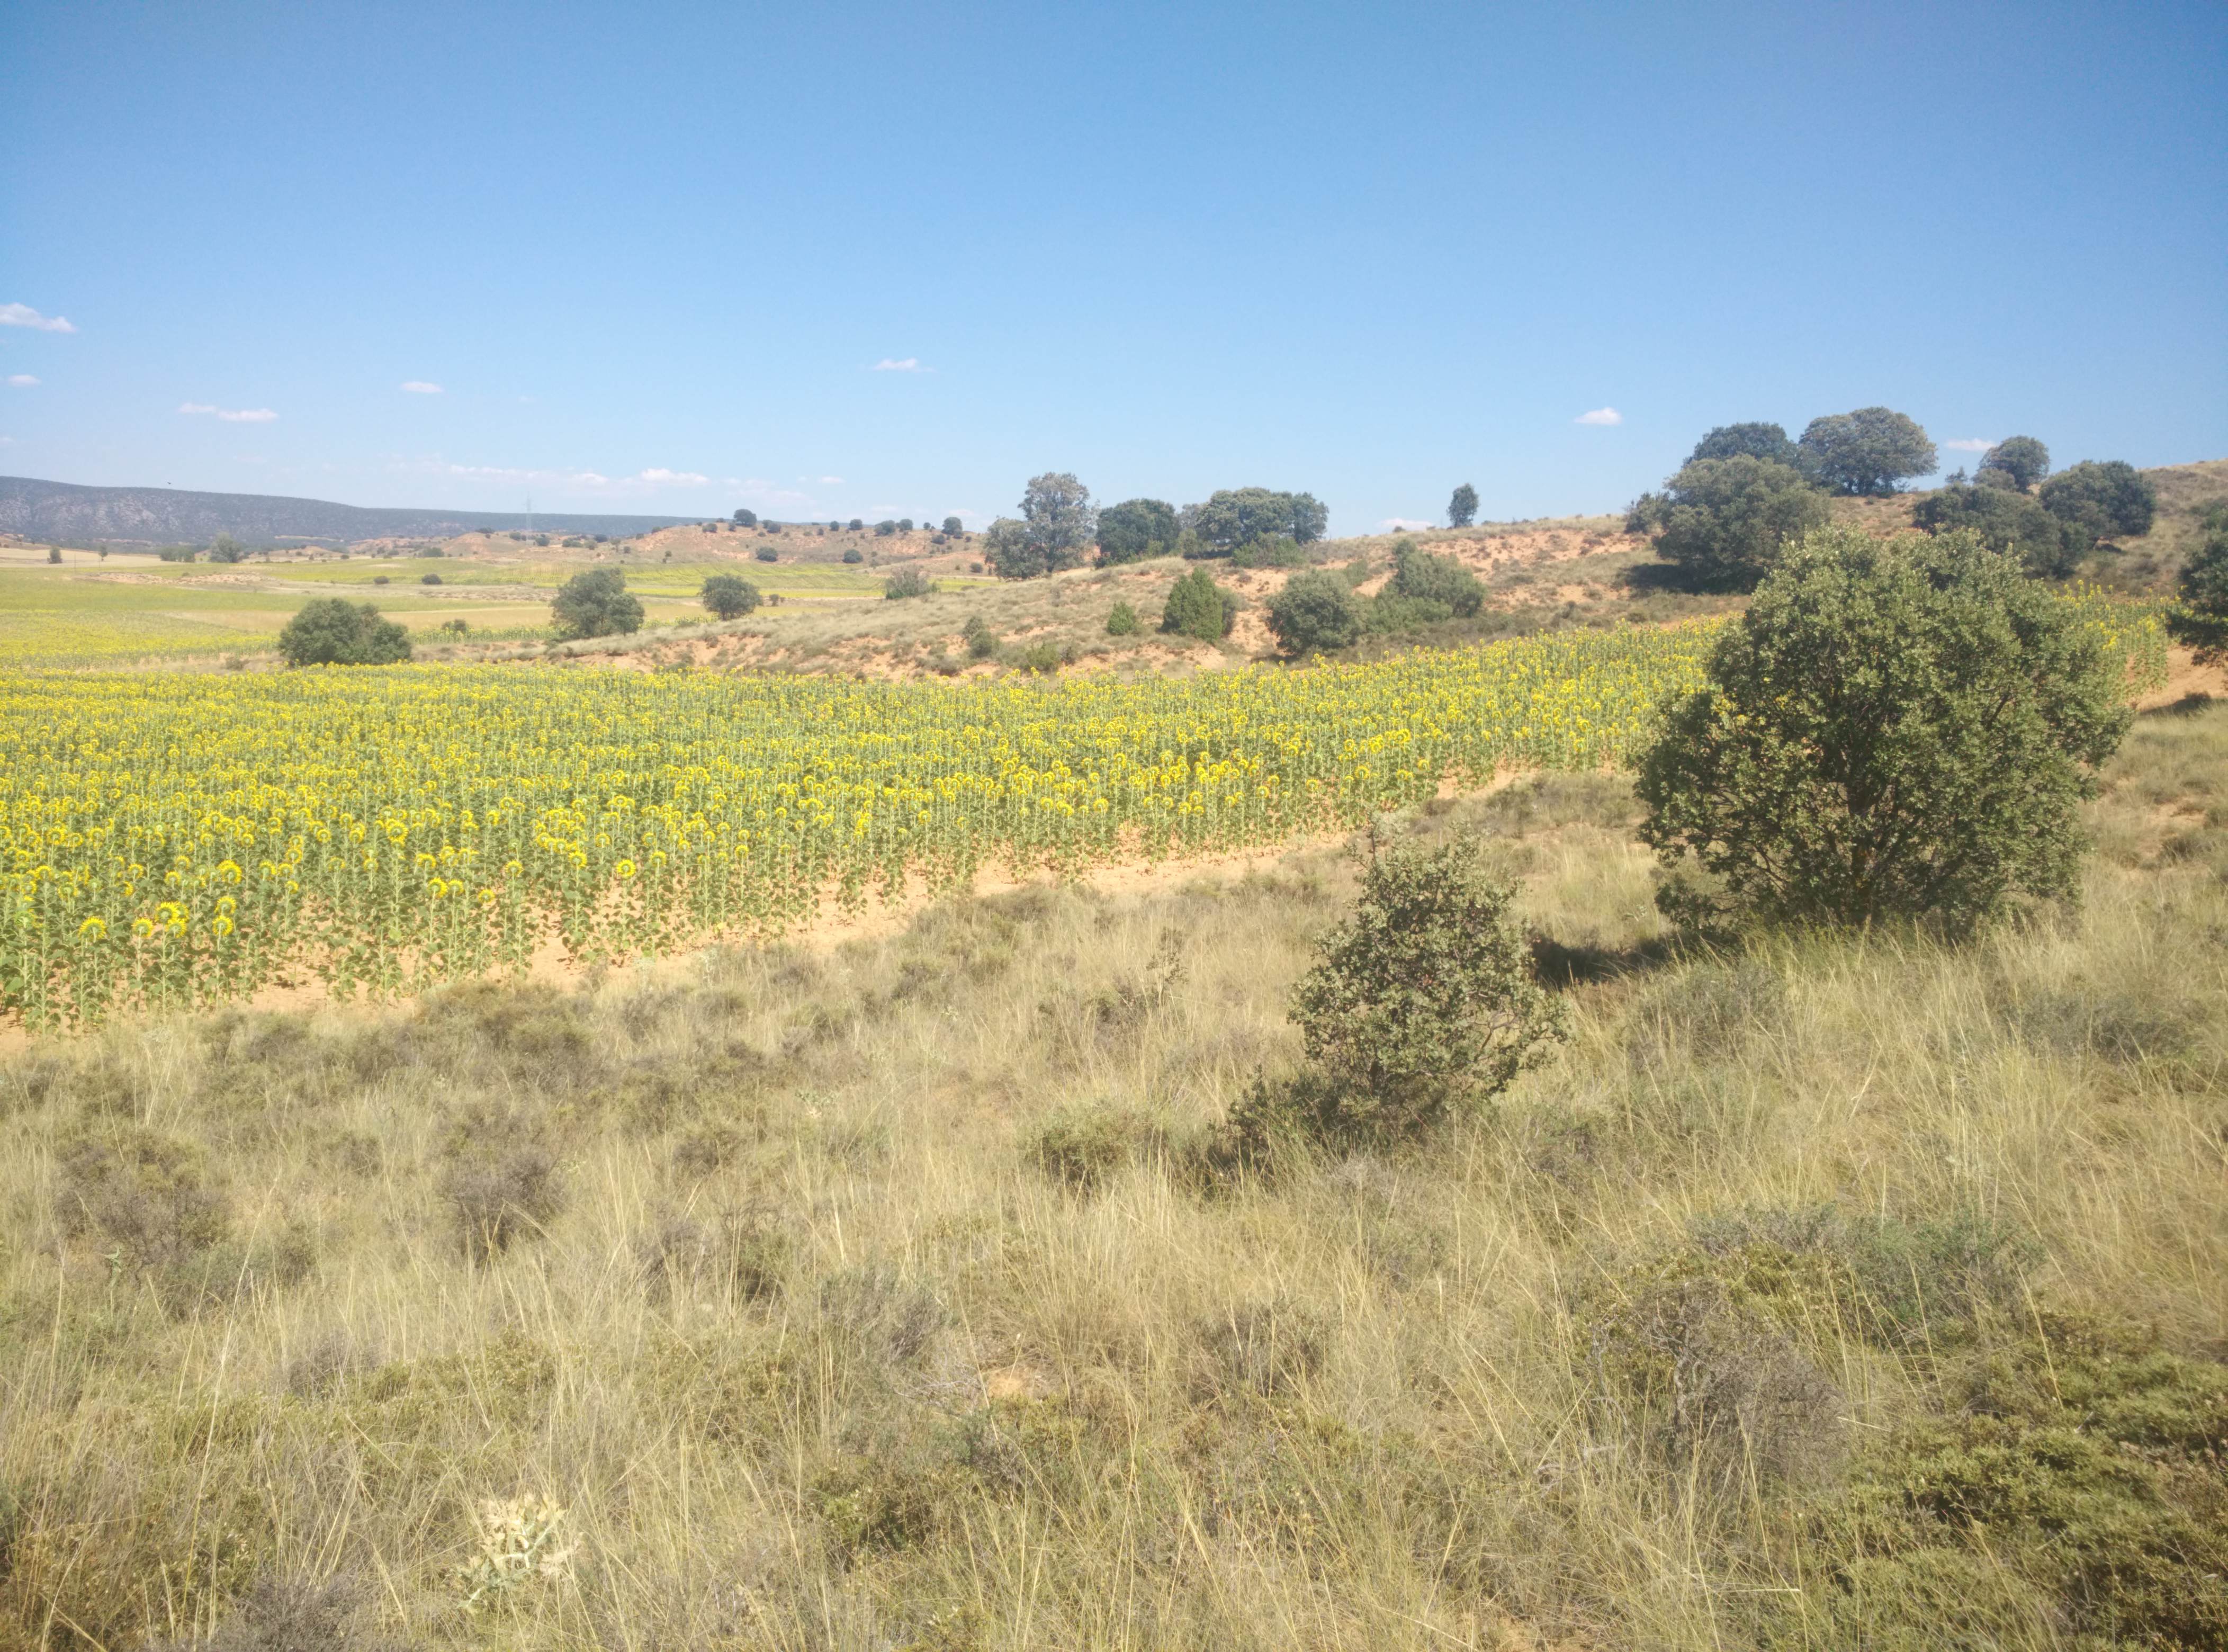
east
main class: Shrubland
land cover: Shrubland without tree cover
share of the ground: 25 - 50 %
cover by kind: shrubs 40 %, unconsolidated bare surface 40 %, herbaceous plants 20 %
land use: Semi-natural and natural areas not in use
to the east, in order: Shrubland without tree cover; Sunflower; Shrubland with sparse tree cover; Sunflower
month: July
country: ES
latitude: 40.8094
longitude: -2.7025
